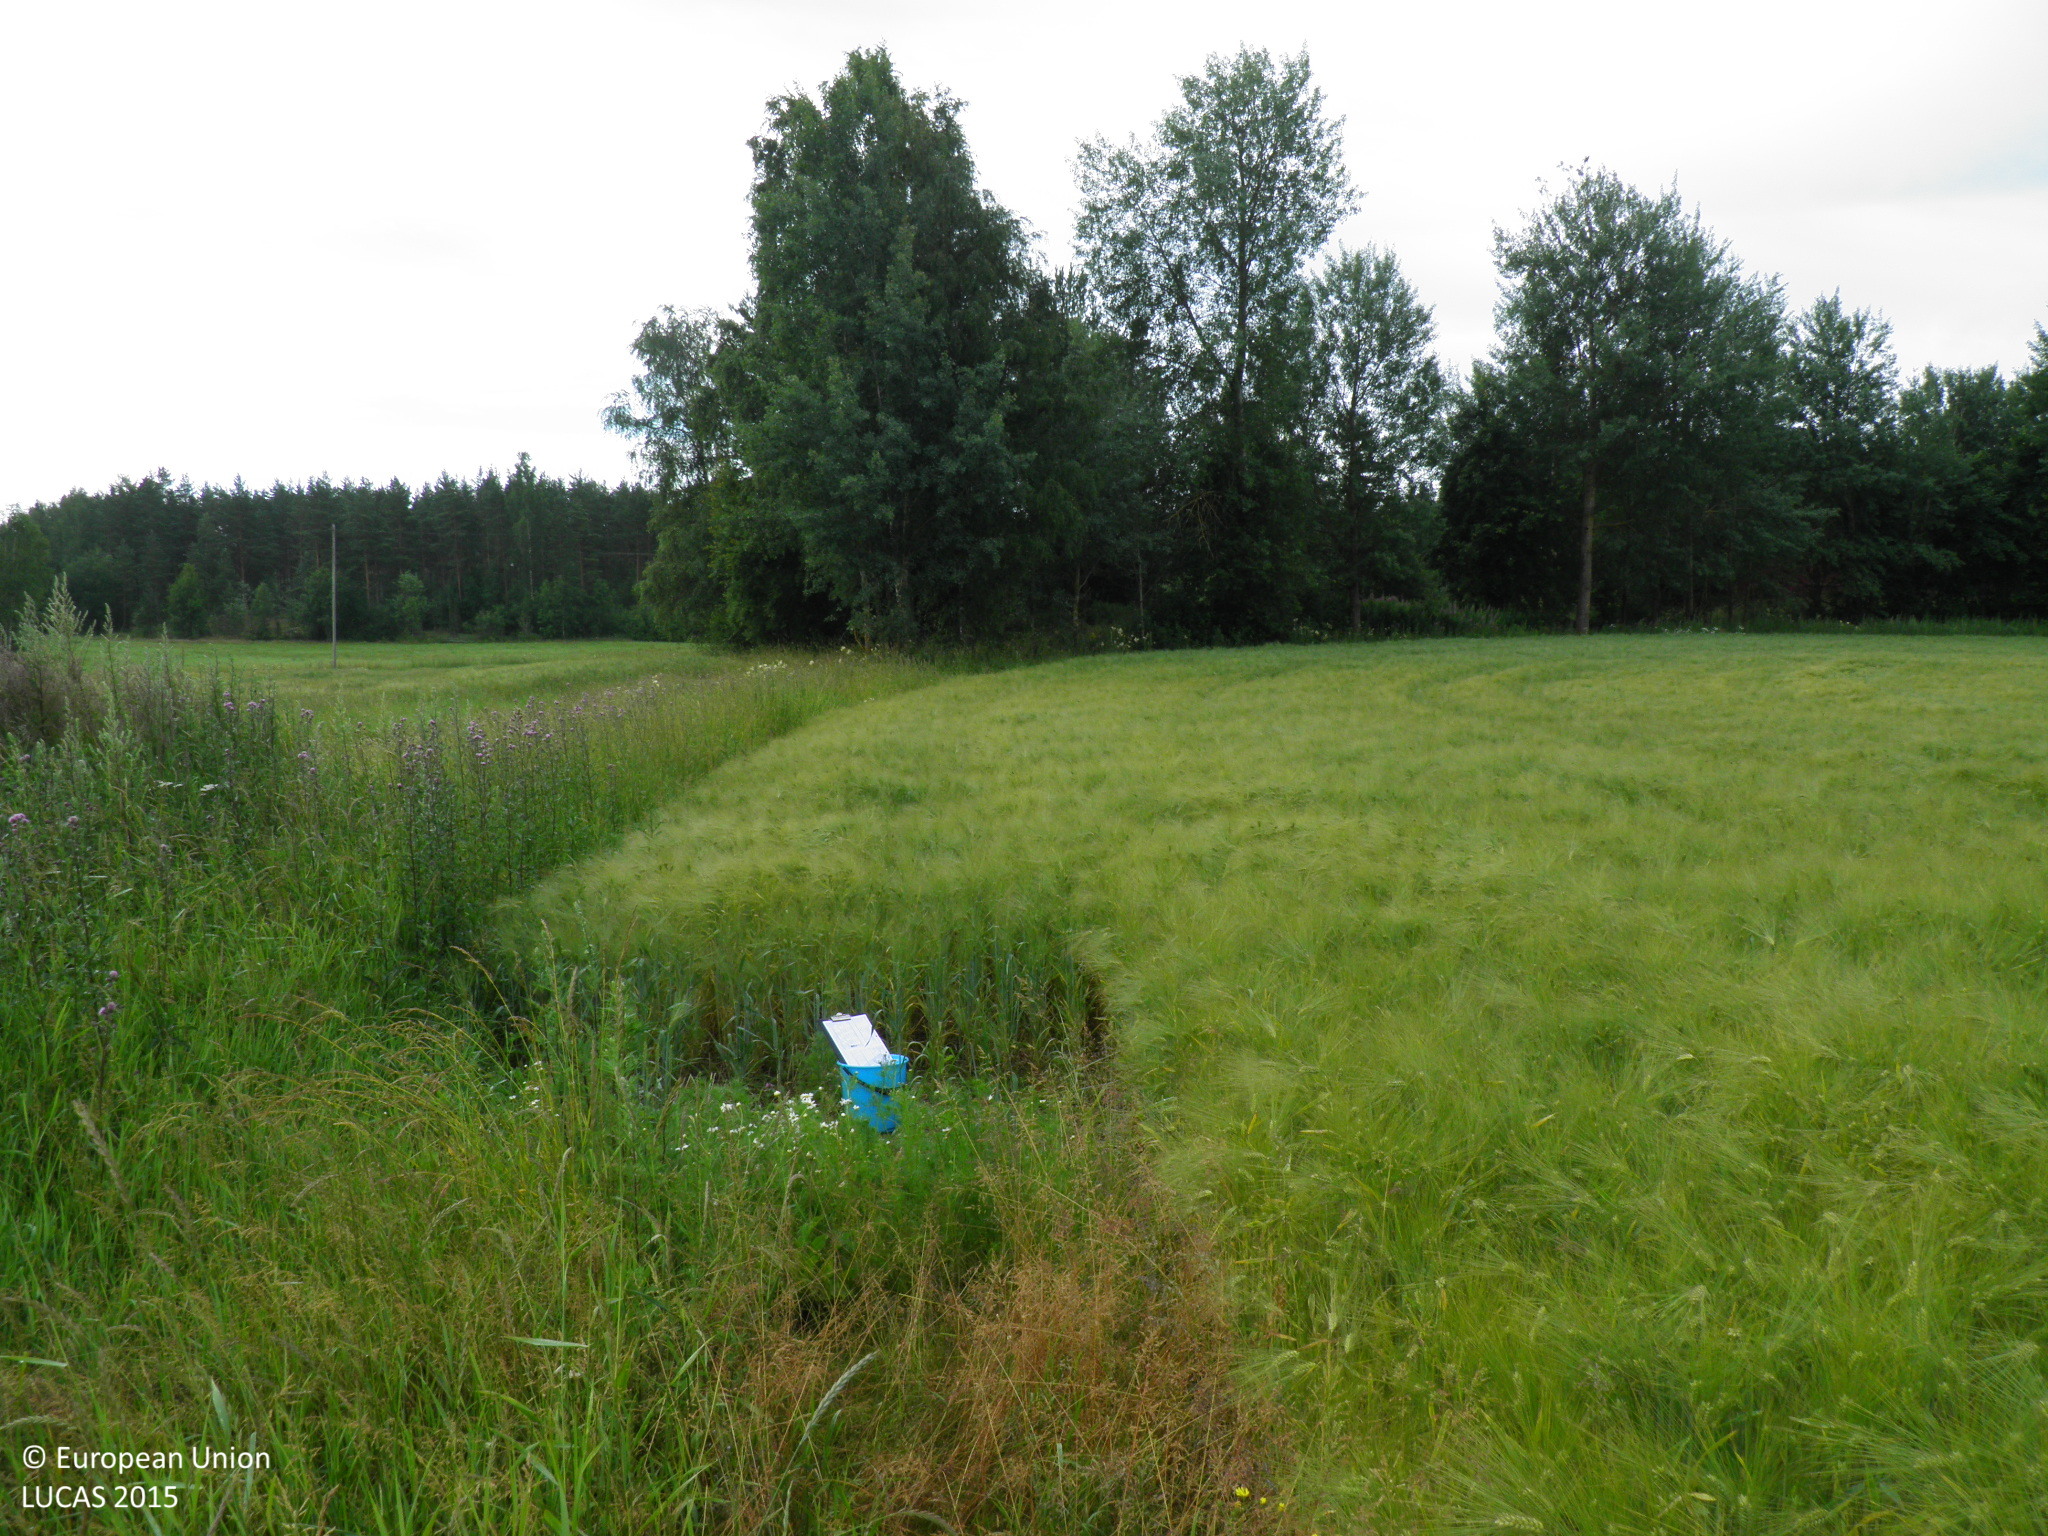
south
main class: Cropland
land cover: Barley
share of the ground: > 75 %
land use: Agriculture (excluding fallow land and kitchen gardens)
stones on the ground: < 10 %
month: July
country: FI
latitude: 60.1483
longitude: 22.7377
